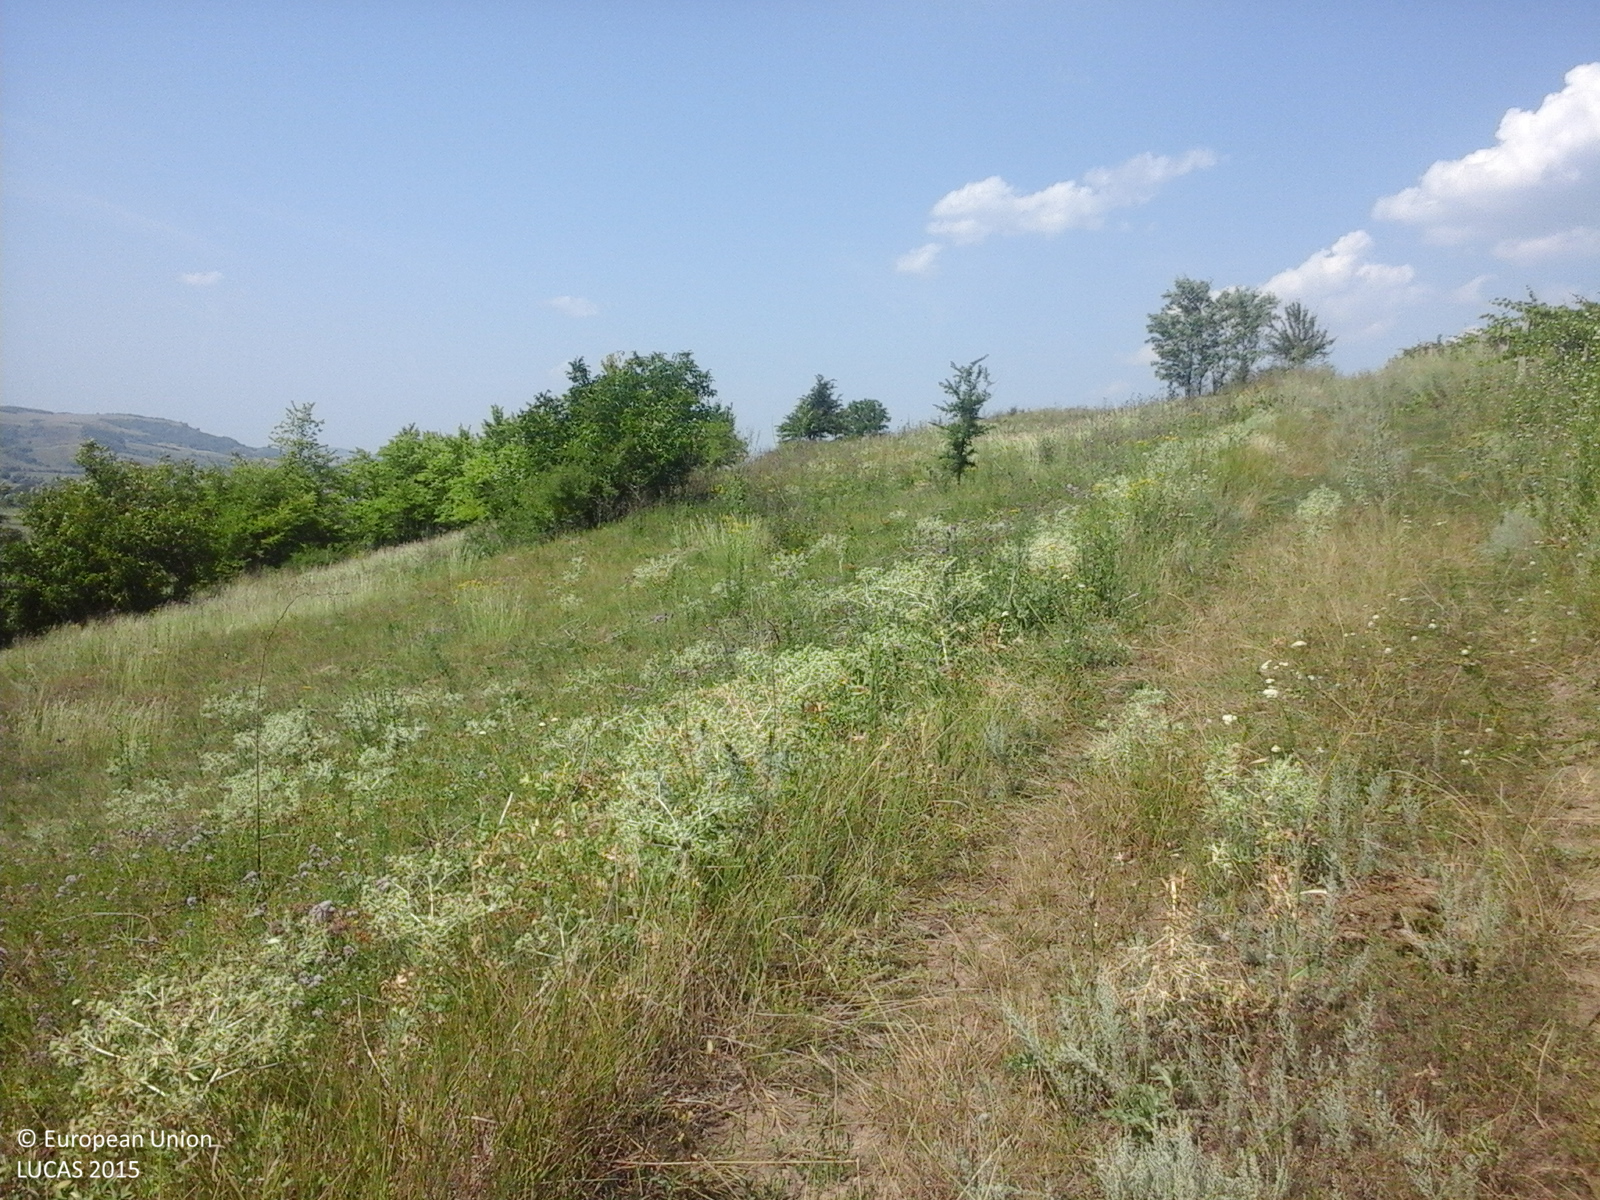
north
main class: Cropland
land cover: Vineyards
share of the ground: > 75 %
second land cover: Spontaneously vegetated surfaces
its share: 10 - 25 %
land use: Agriculture (excluding fallow land and kitchen gardens)
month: July
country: RO
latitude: 46.3849
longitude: 27.2800
